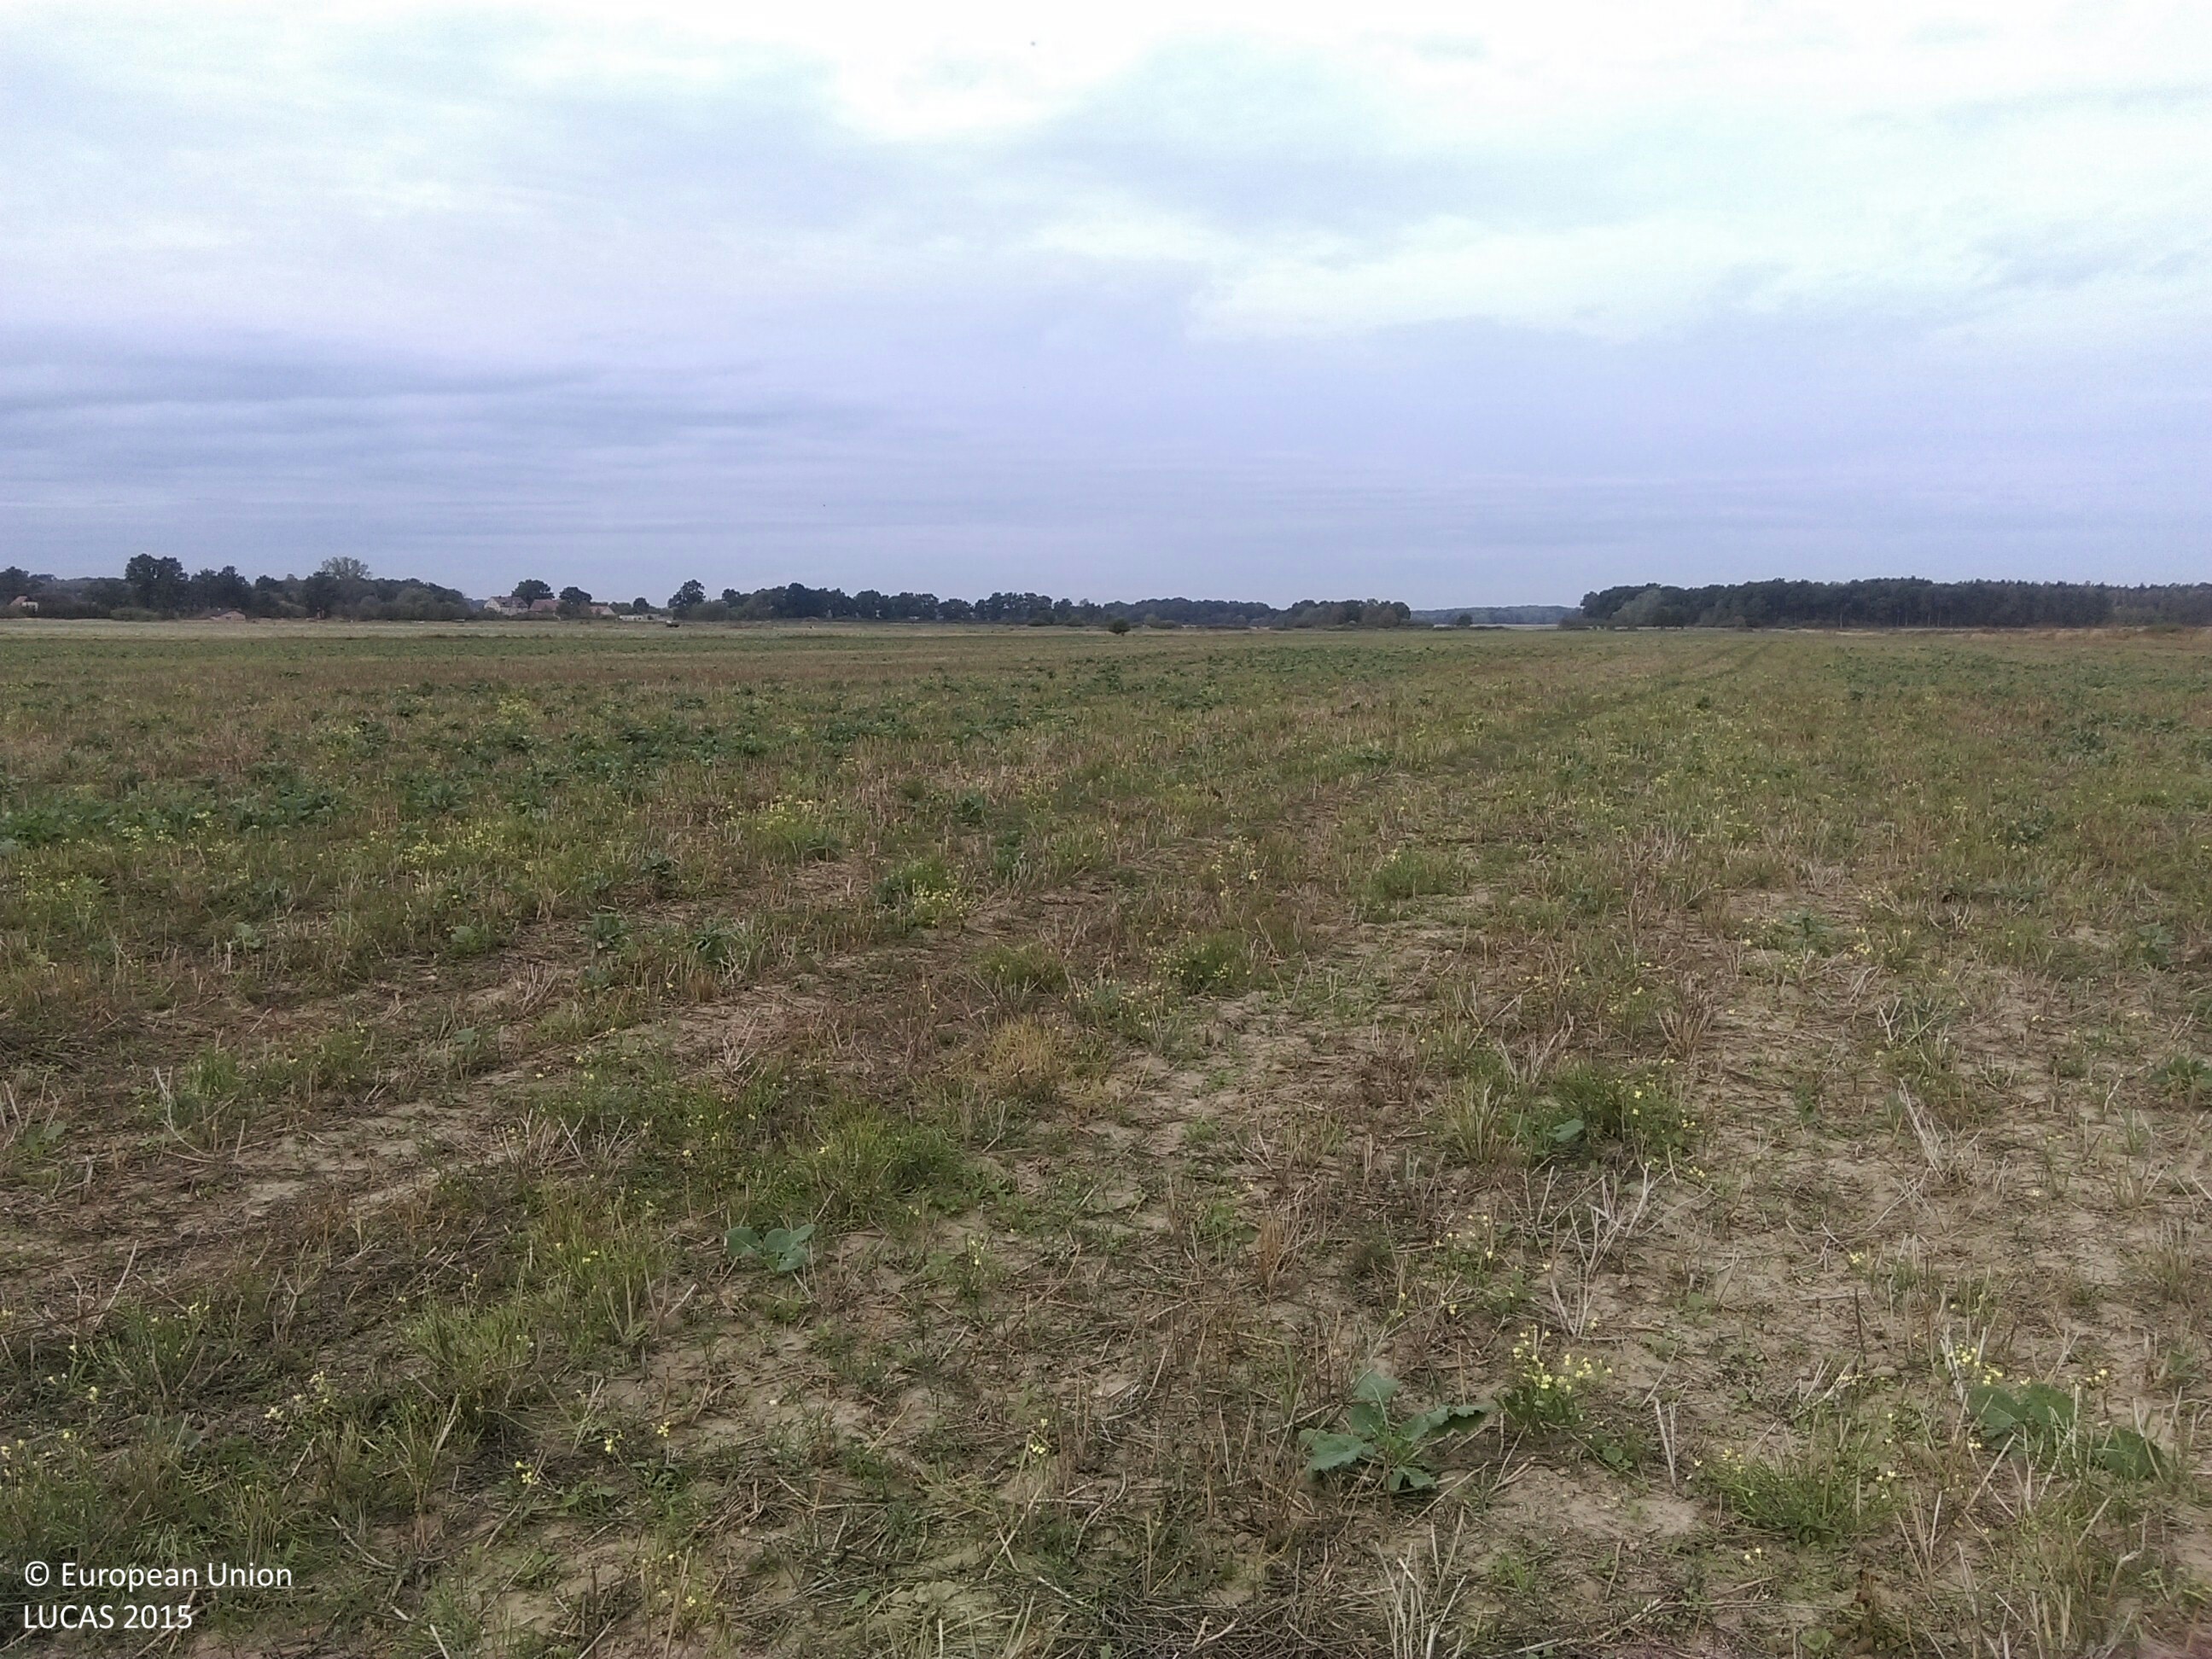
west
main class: Cropland
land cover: Rape and turnip rape
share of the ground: < 10 %
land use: Agriculture (excluding fallow land and kitchen gardens)
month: September
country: PL
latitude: 51.5998
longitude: 15.5337
